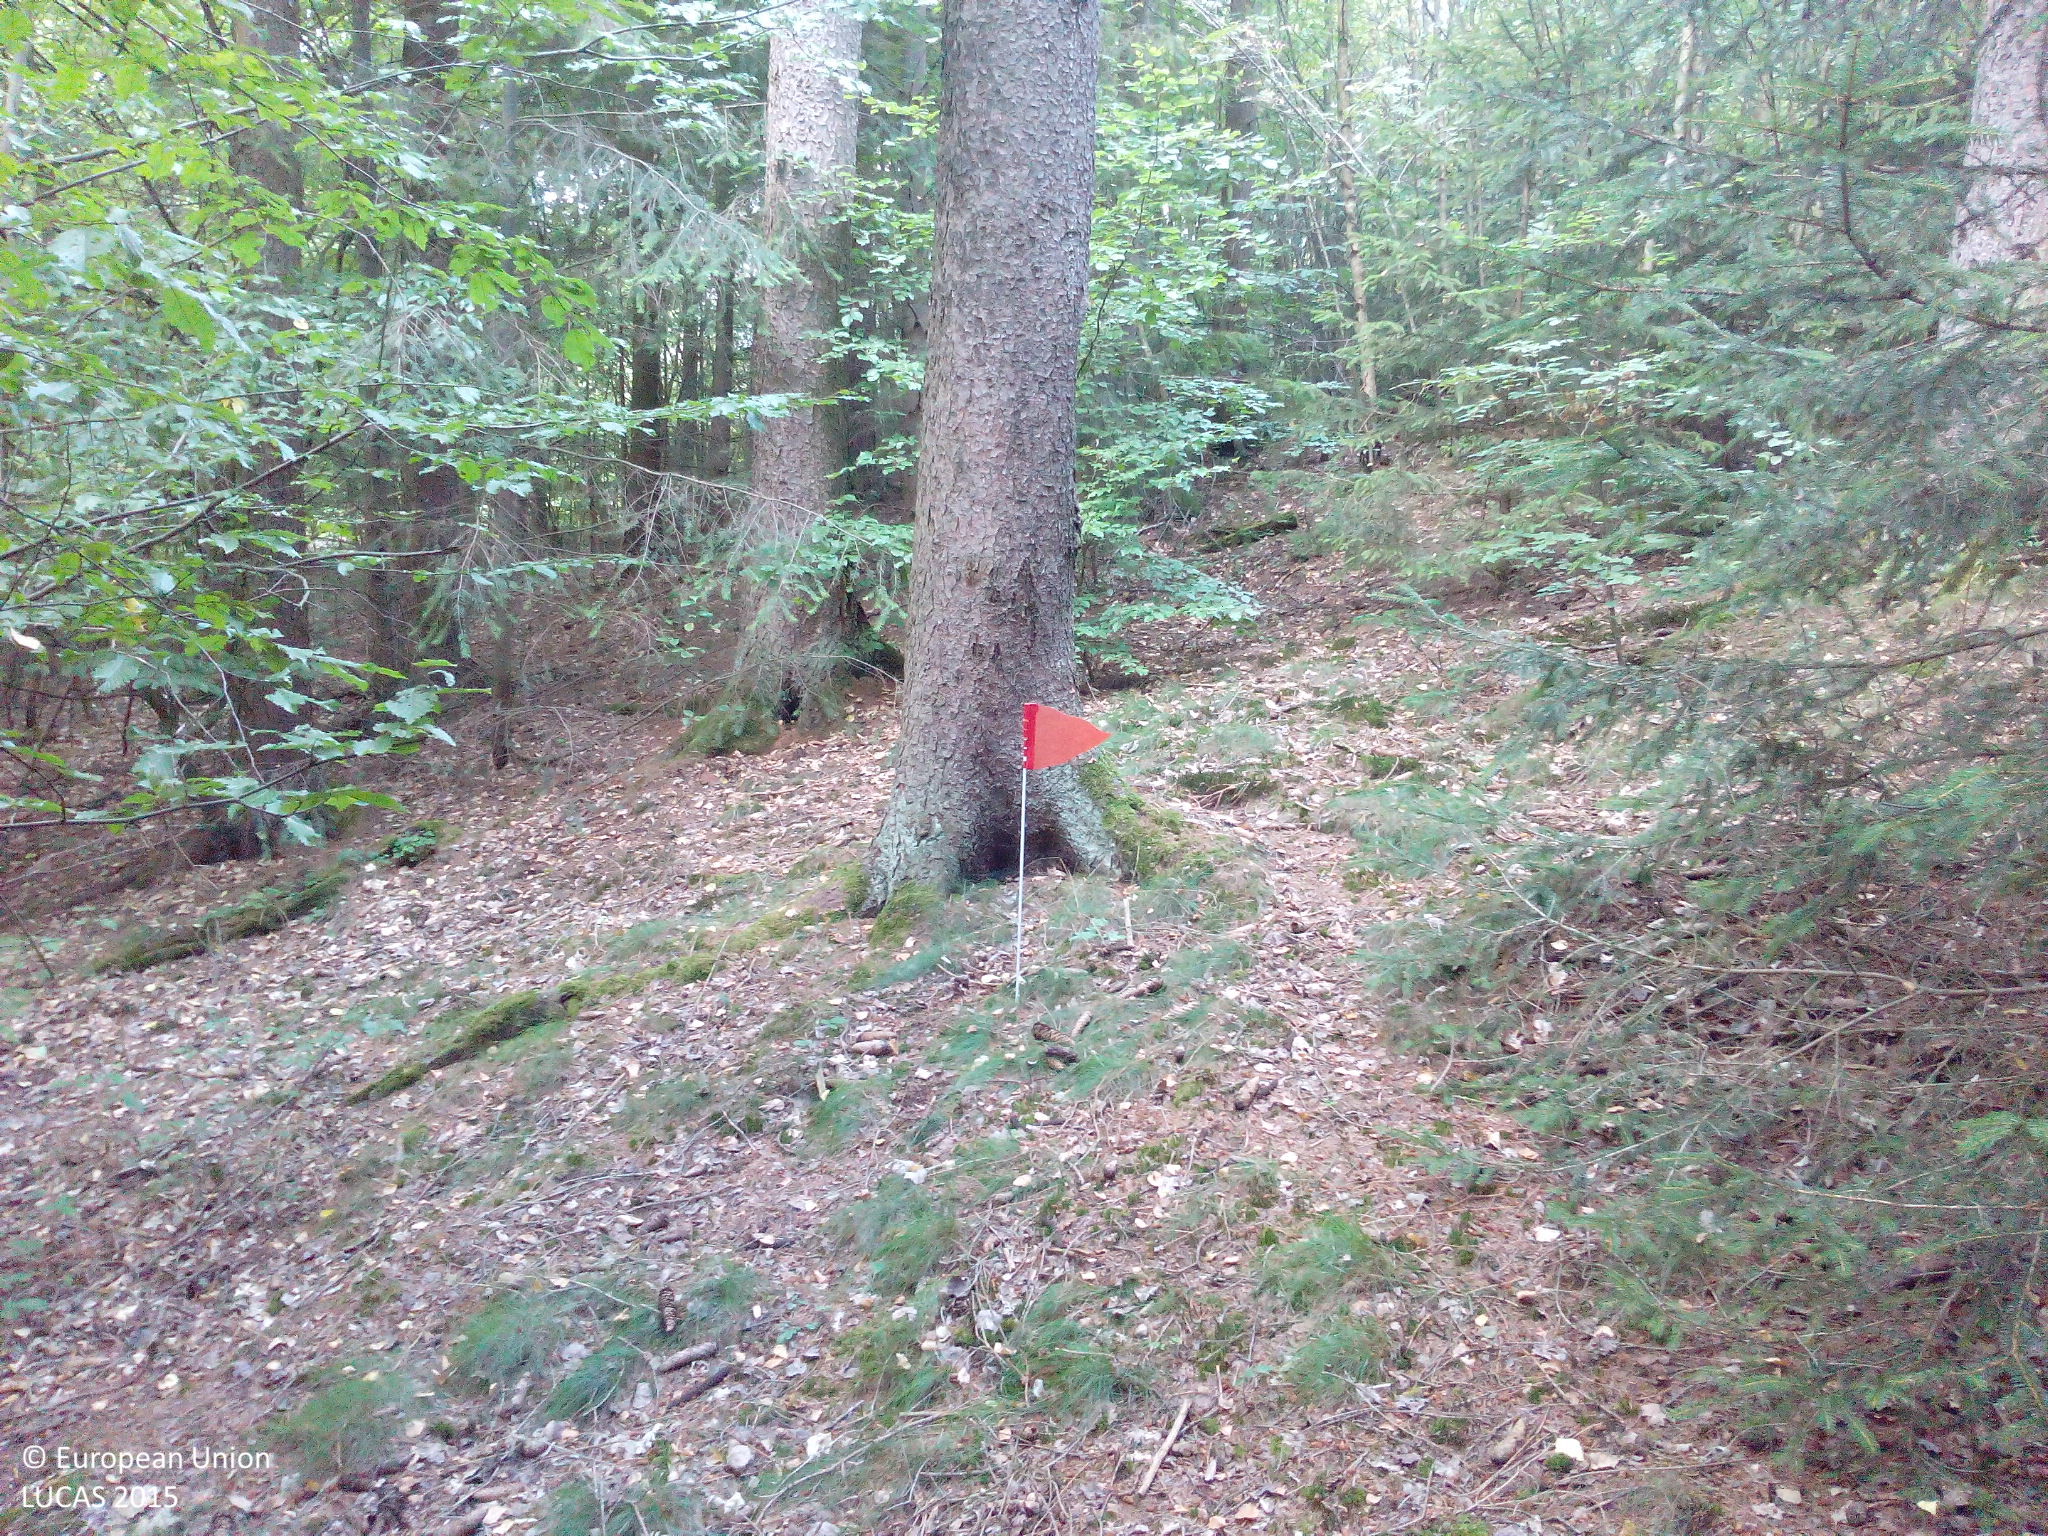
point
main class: Woodland
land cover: Spruce dominated mixed woodland
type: mesophytic deciduous forest
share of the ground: > 75 %
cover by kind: coniferous forest trees 50 %, broadleaved forest trees 25 %, herbaceous plants 10 %, lichens and mosses 10 %, unconsolidated bare surface 5 %
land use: Forestry
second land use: Amenities, museums, leisure
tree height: > 5 m
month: August
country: DE
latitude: 50.2119
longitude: 7.5480
